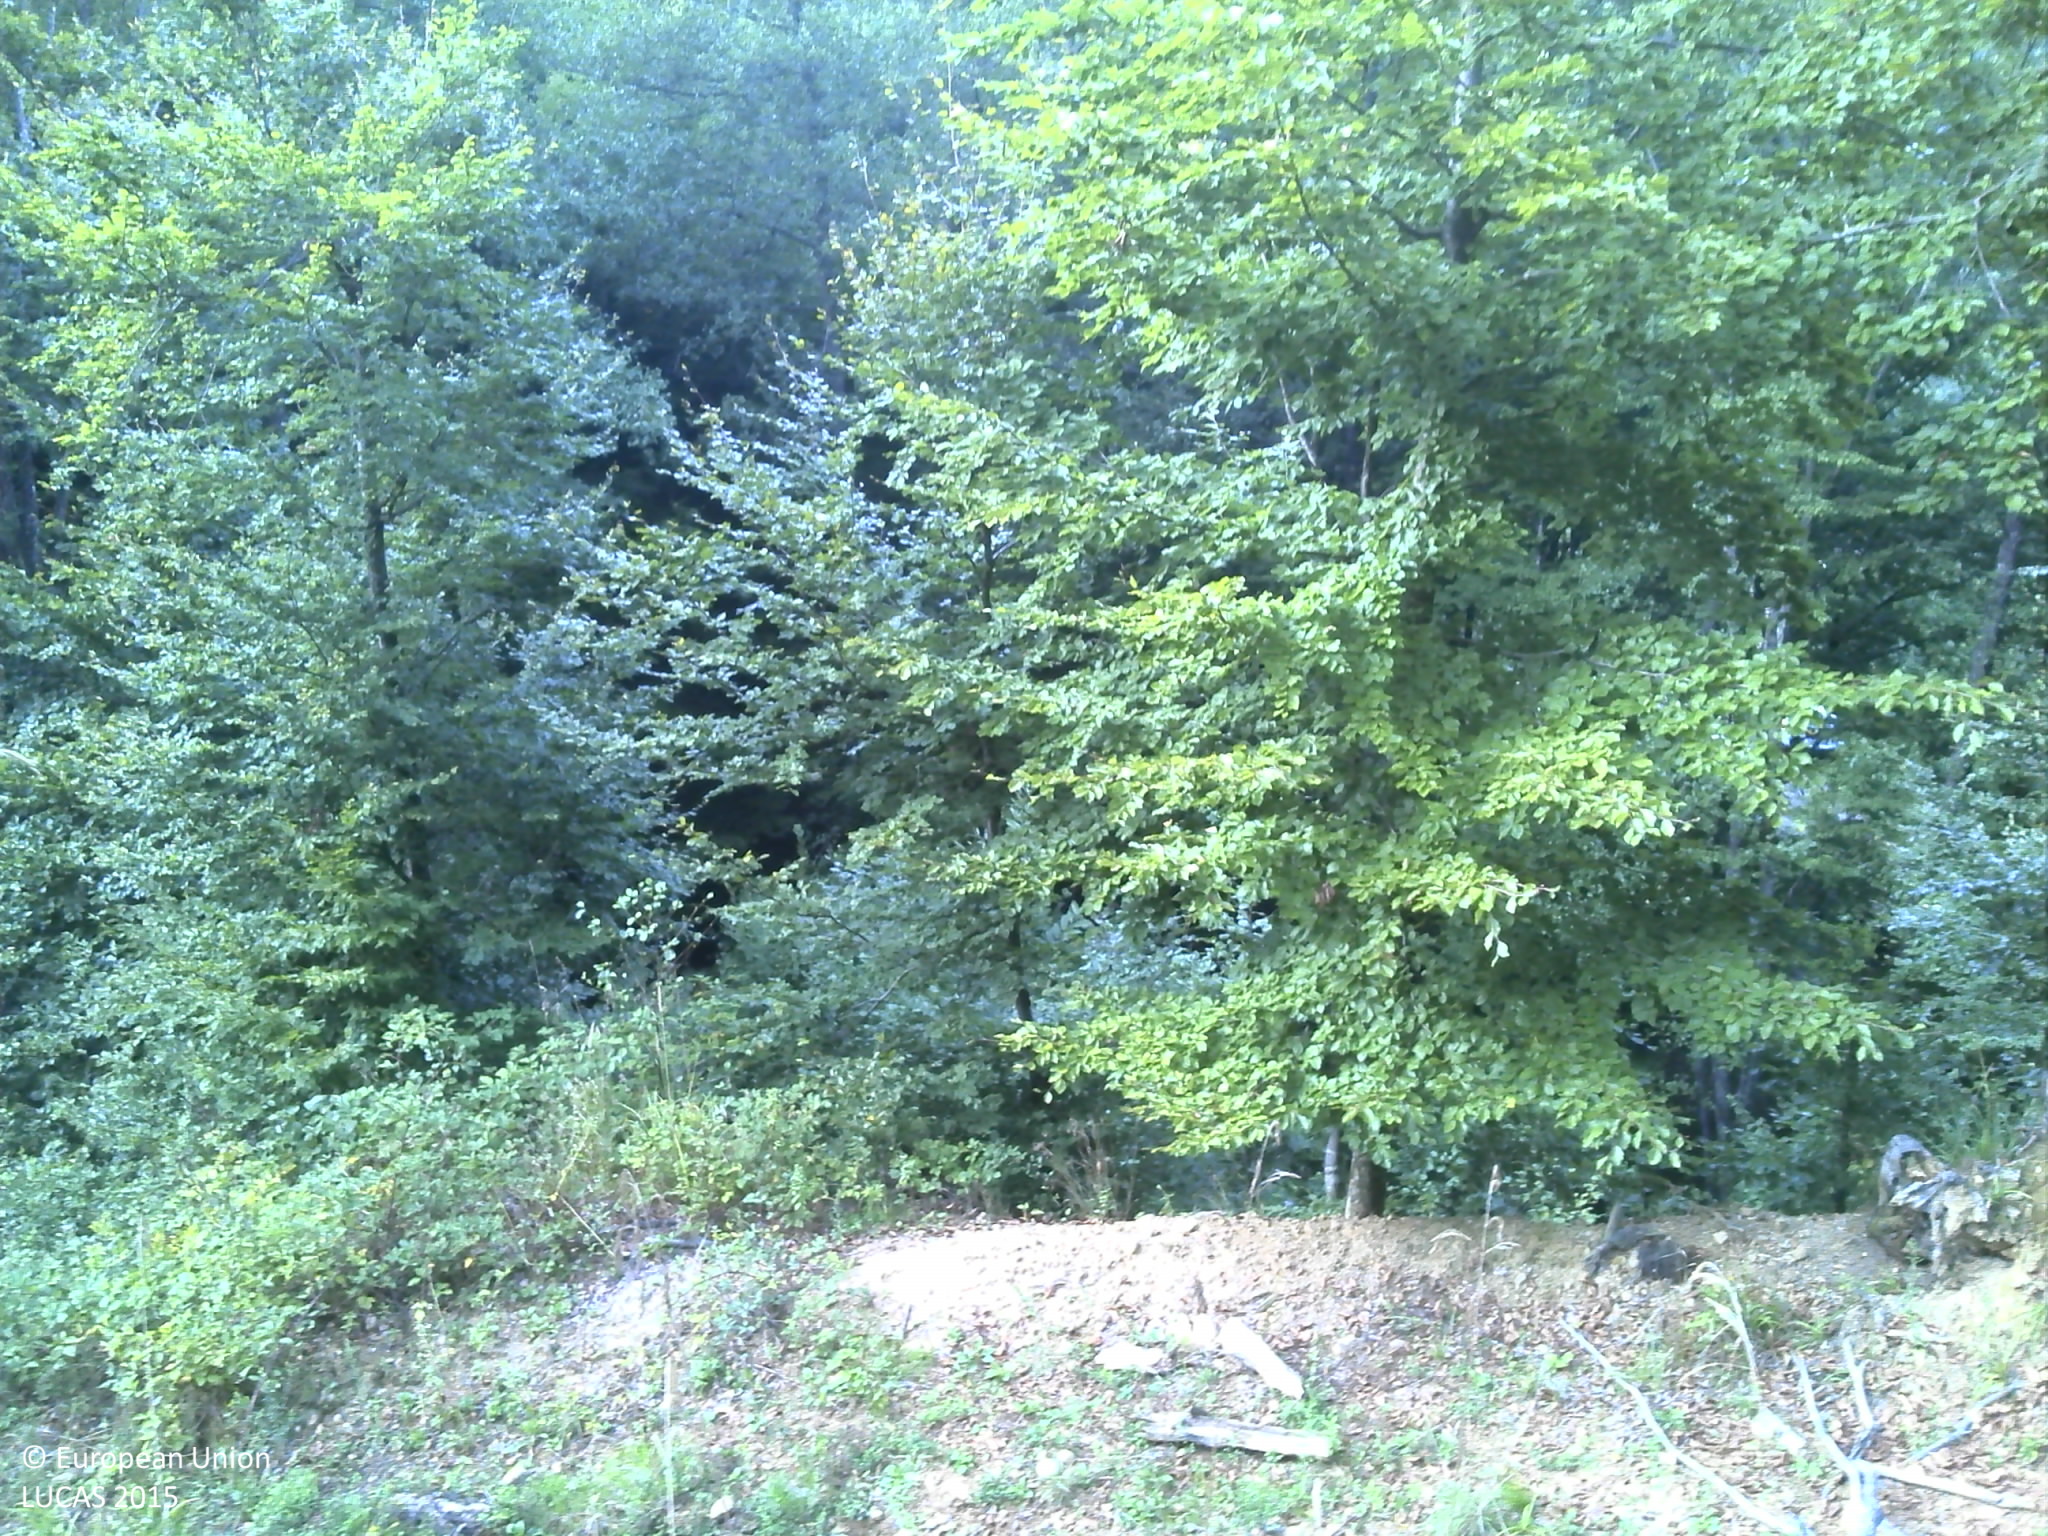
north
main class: Woodland
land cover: Broadleaved woodland
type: acidophilous oak and oak-birch forest
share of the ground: 25 - 50 %
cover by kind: herbaceous plants 45 %, broadleaved forest trees 30 %, shrubs 25 %
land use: Forestry
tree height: > 5 m
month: August
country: HR
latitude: 45.2781
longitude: 16.3327
